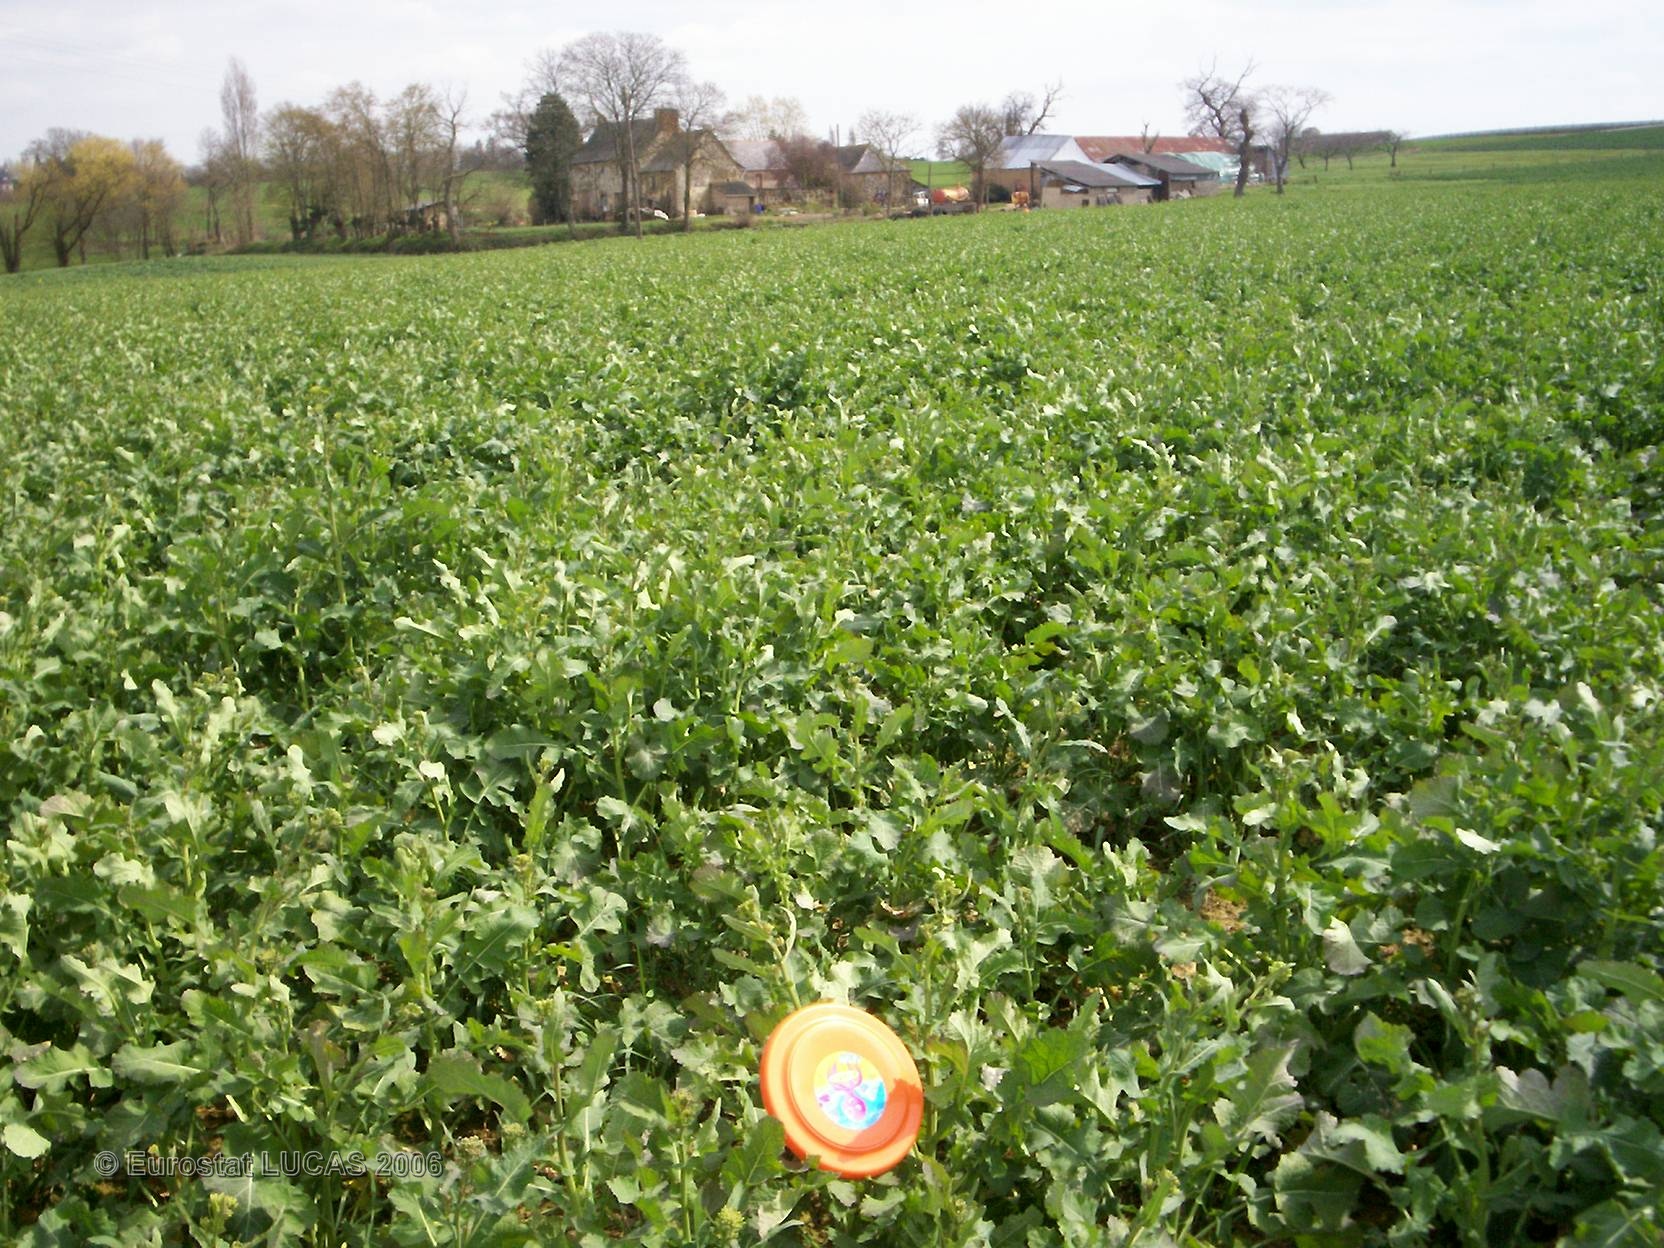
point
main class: Cropland
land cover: Rape and turnip rape
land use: Agriculture (excluding fallow land and kitchen gardens)
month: April
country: FR
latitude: 47.9923
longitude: -1.5841
